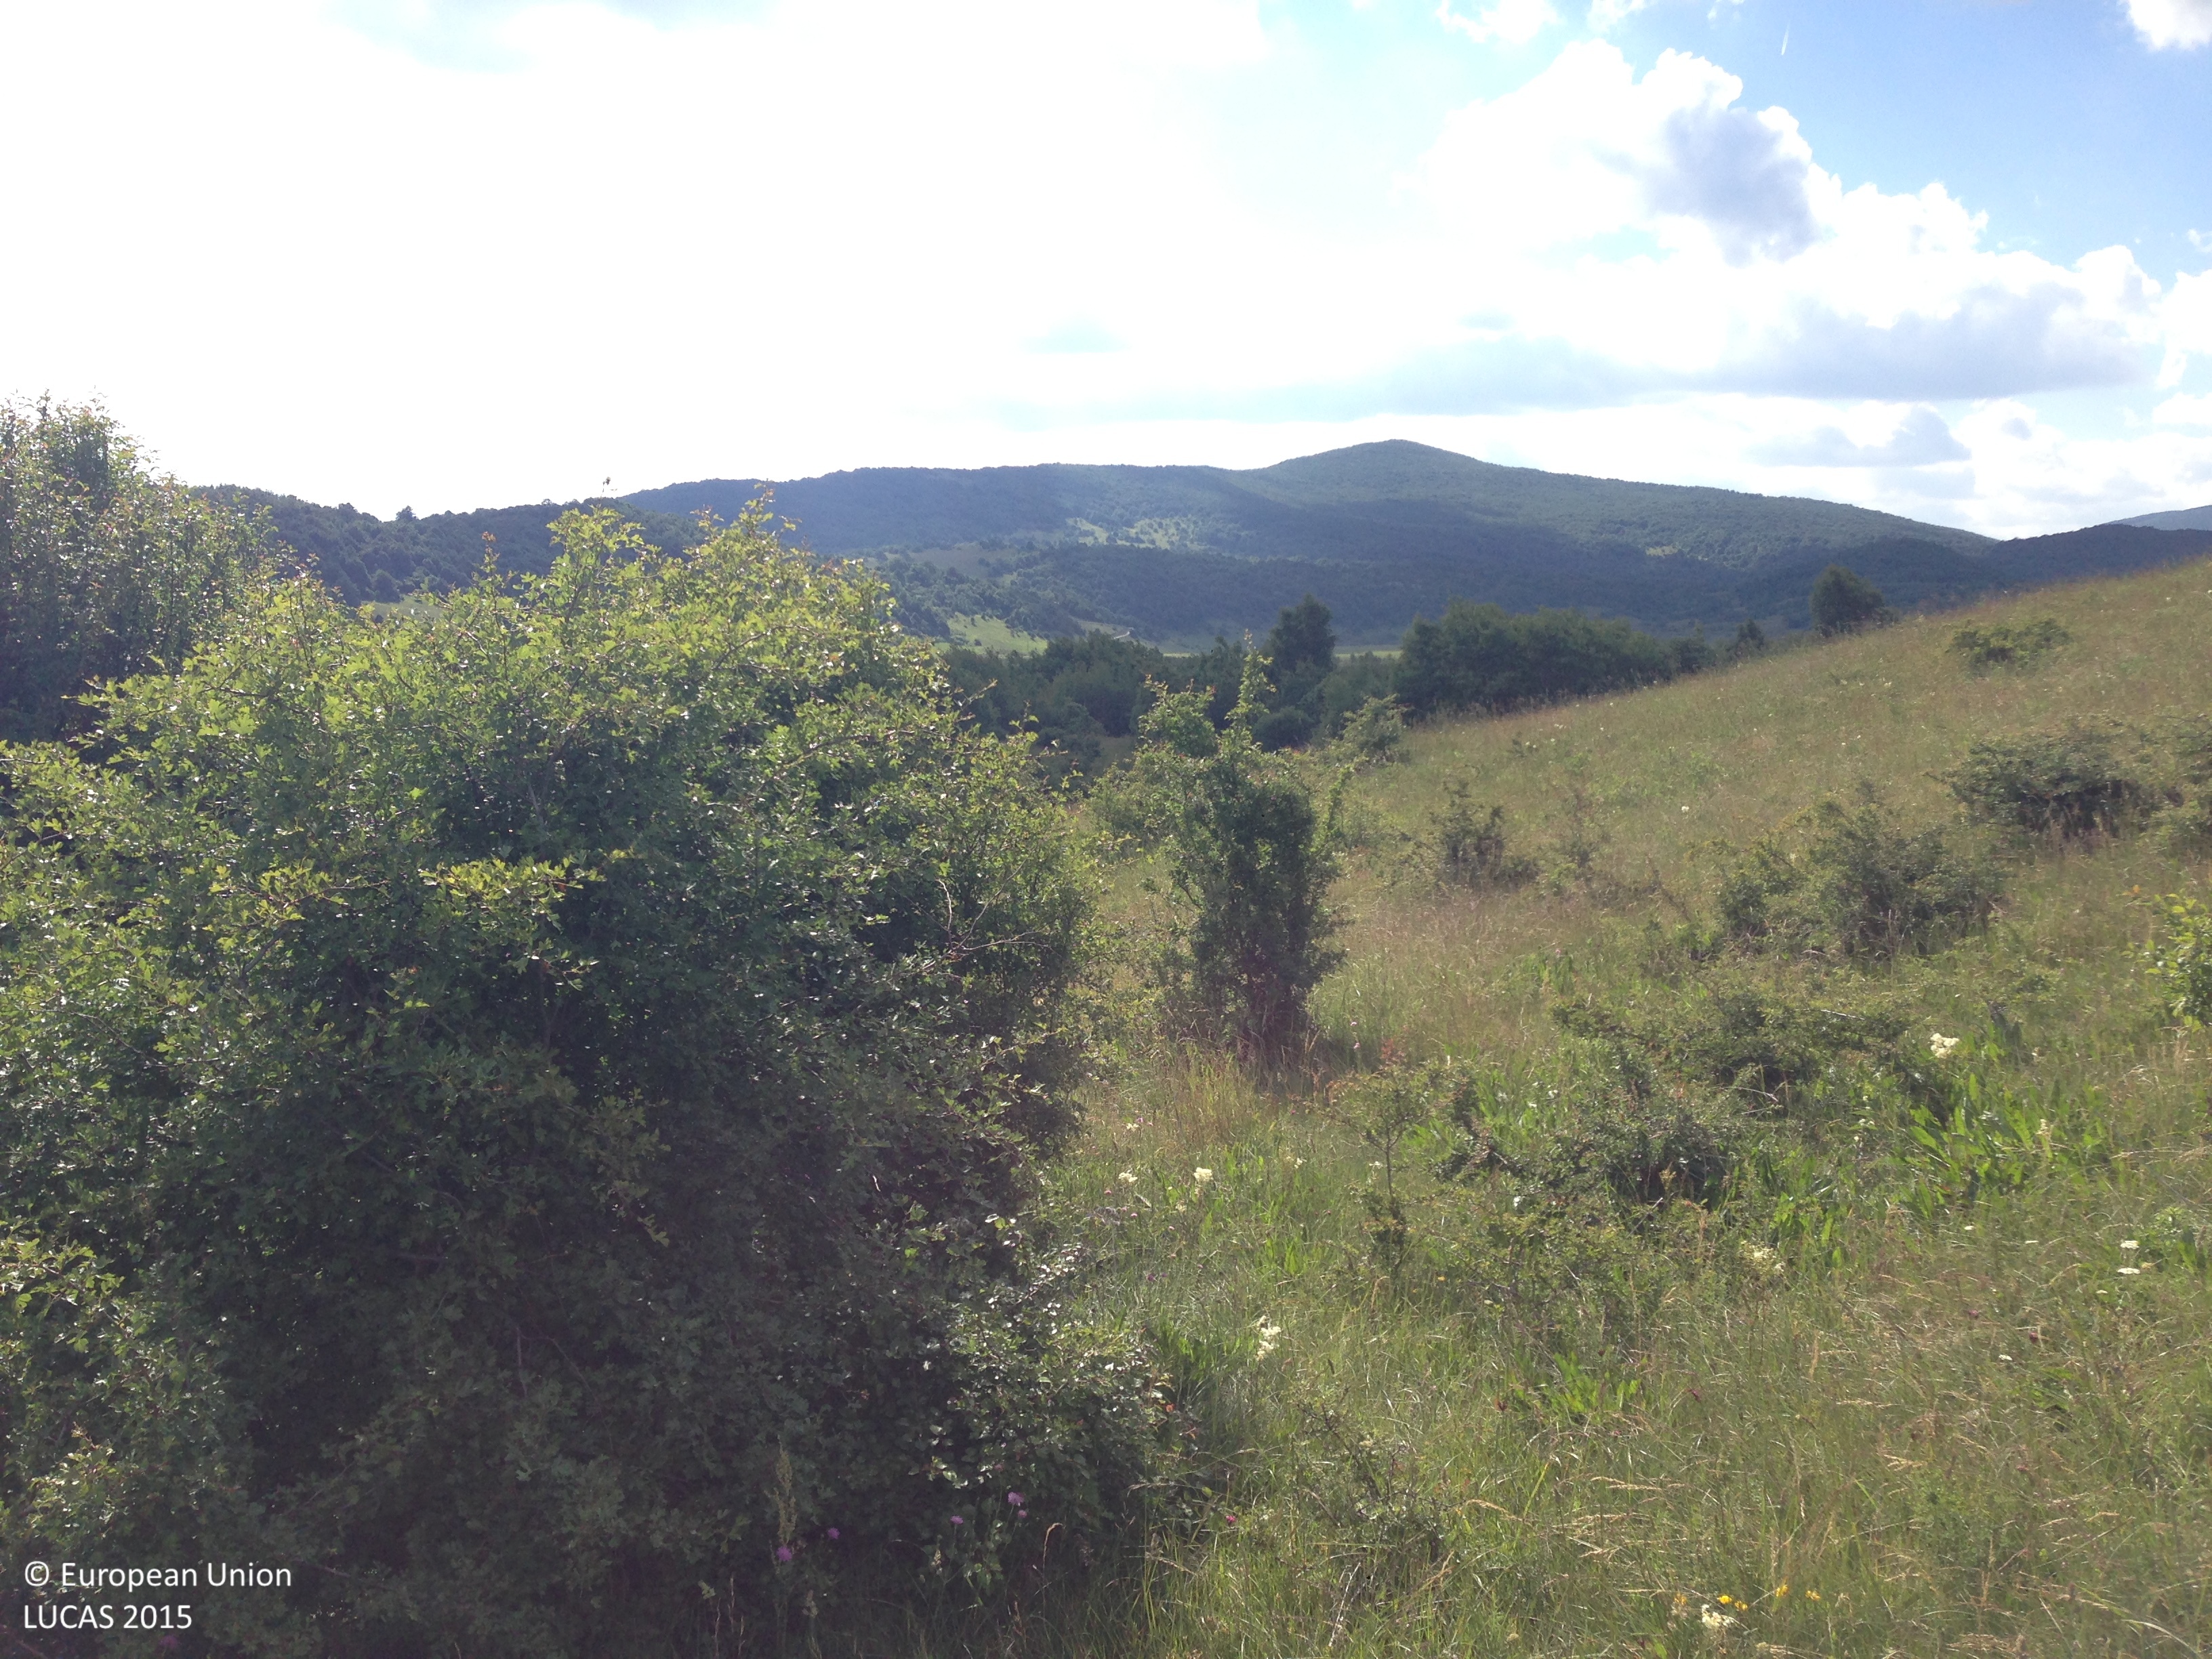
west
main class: Grassland
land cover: Grassland with sparse tree/shrub cover
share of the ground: > 75 %
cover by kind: herbaceous plants 85 %, broadleaved forest trees 5 %, shrubs 5 %, unconsolidated bare surface 5 %
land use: Agriculture (excluding fallow land and kitchen gardens)
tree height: < 5 m
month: June
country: HR
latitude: 44.7587
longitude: 15.6159
